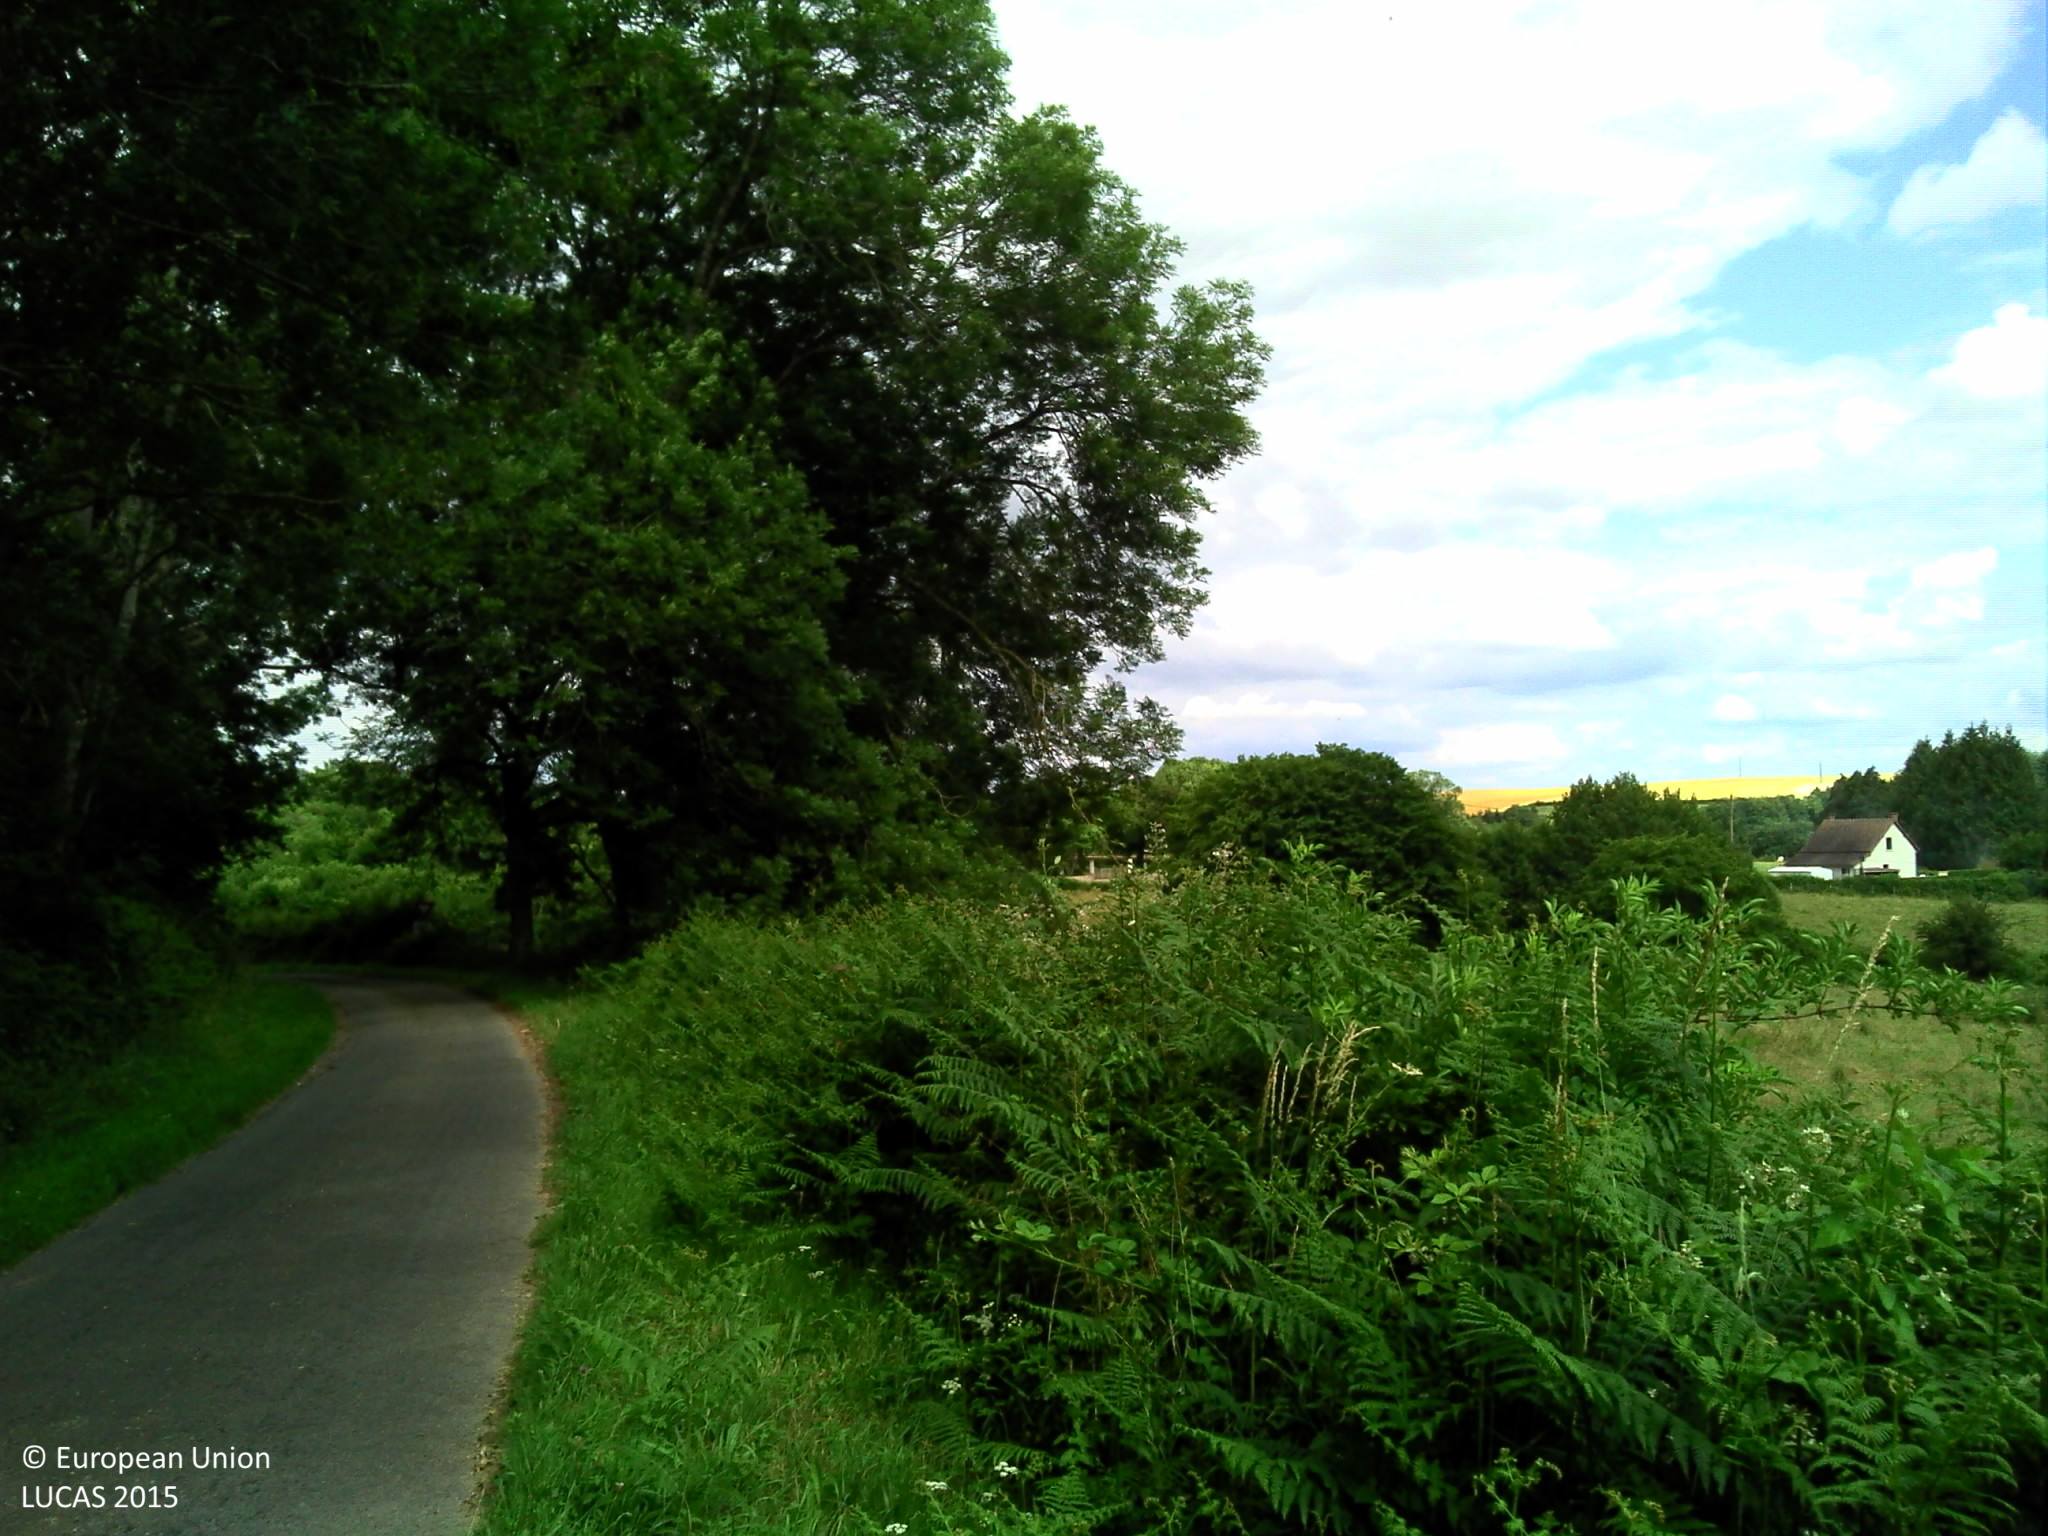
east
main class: Grassland
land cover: Grassland without tree/shrub cover
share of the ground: > 75 %
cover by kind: herbaceous plants 95 %, shrubs 5 %
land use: Agriculture (excluding fallow land and kitchen gardens)
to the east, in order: Grassland without tree/shrub cover; Rivers and streams; Grassland without tree/shrub cover; Artificial constructions in urban areas; Grass margins; Ditches and canals; Fences; Electric lines; Grassland without tree/shrub cover
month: June
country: FR
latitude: 46.1754
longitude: 2.9903
